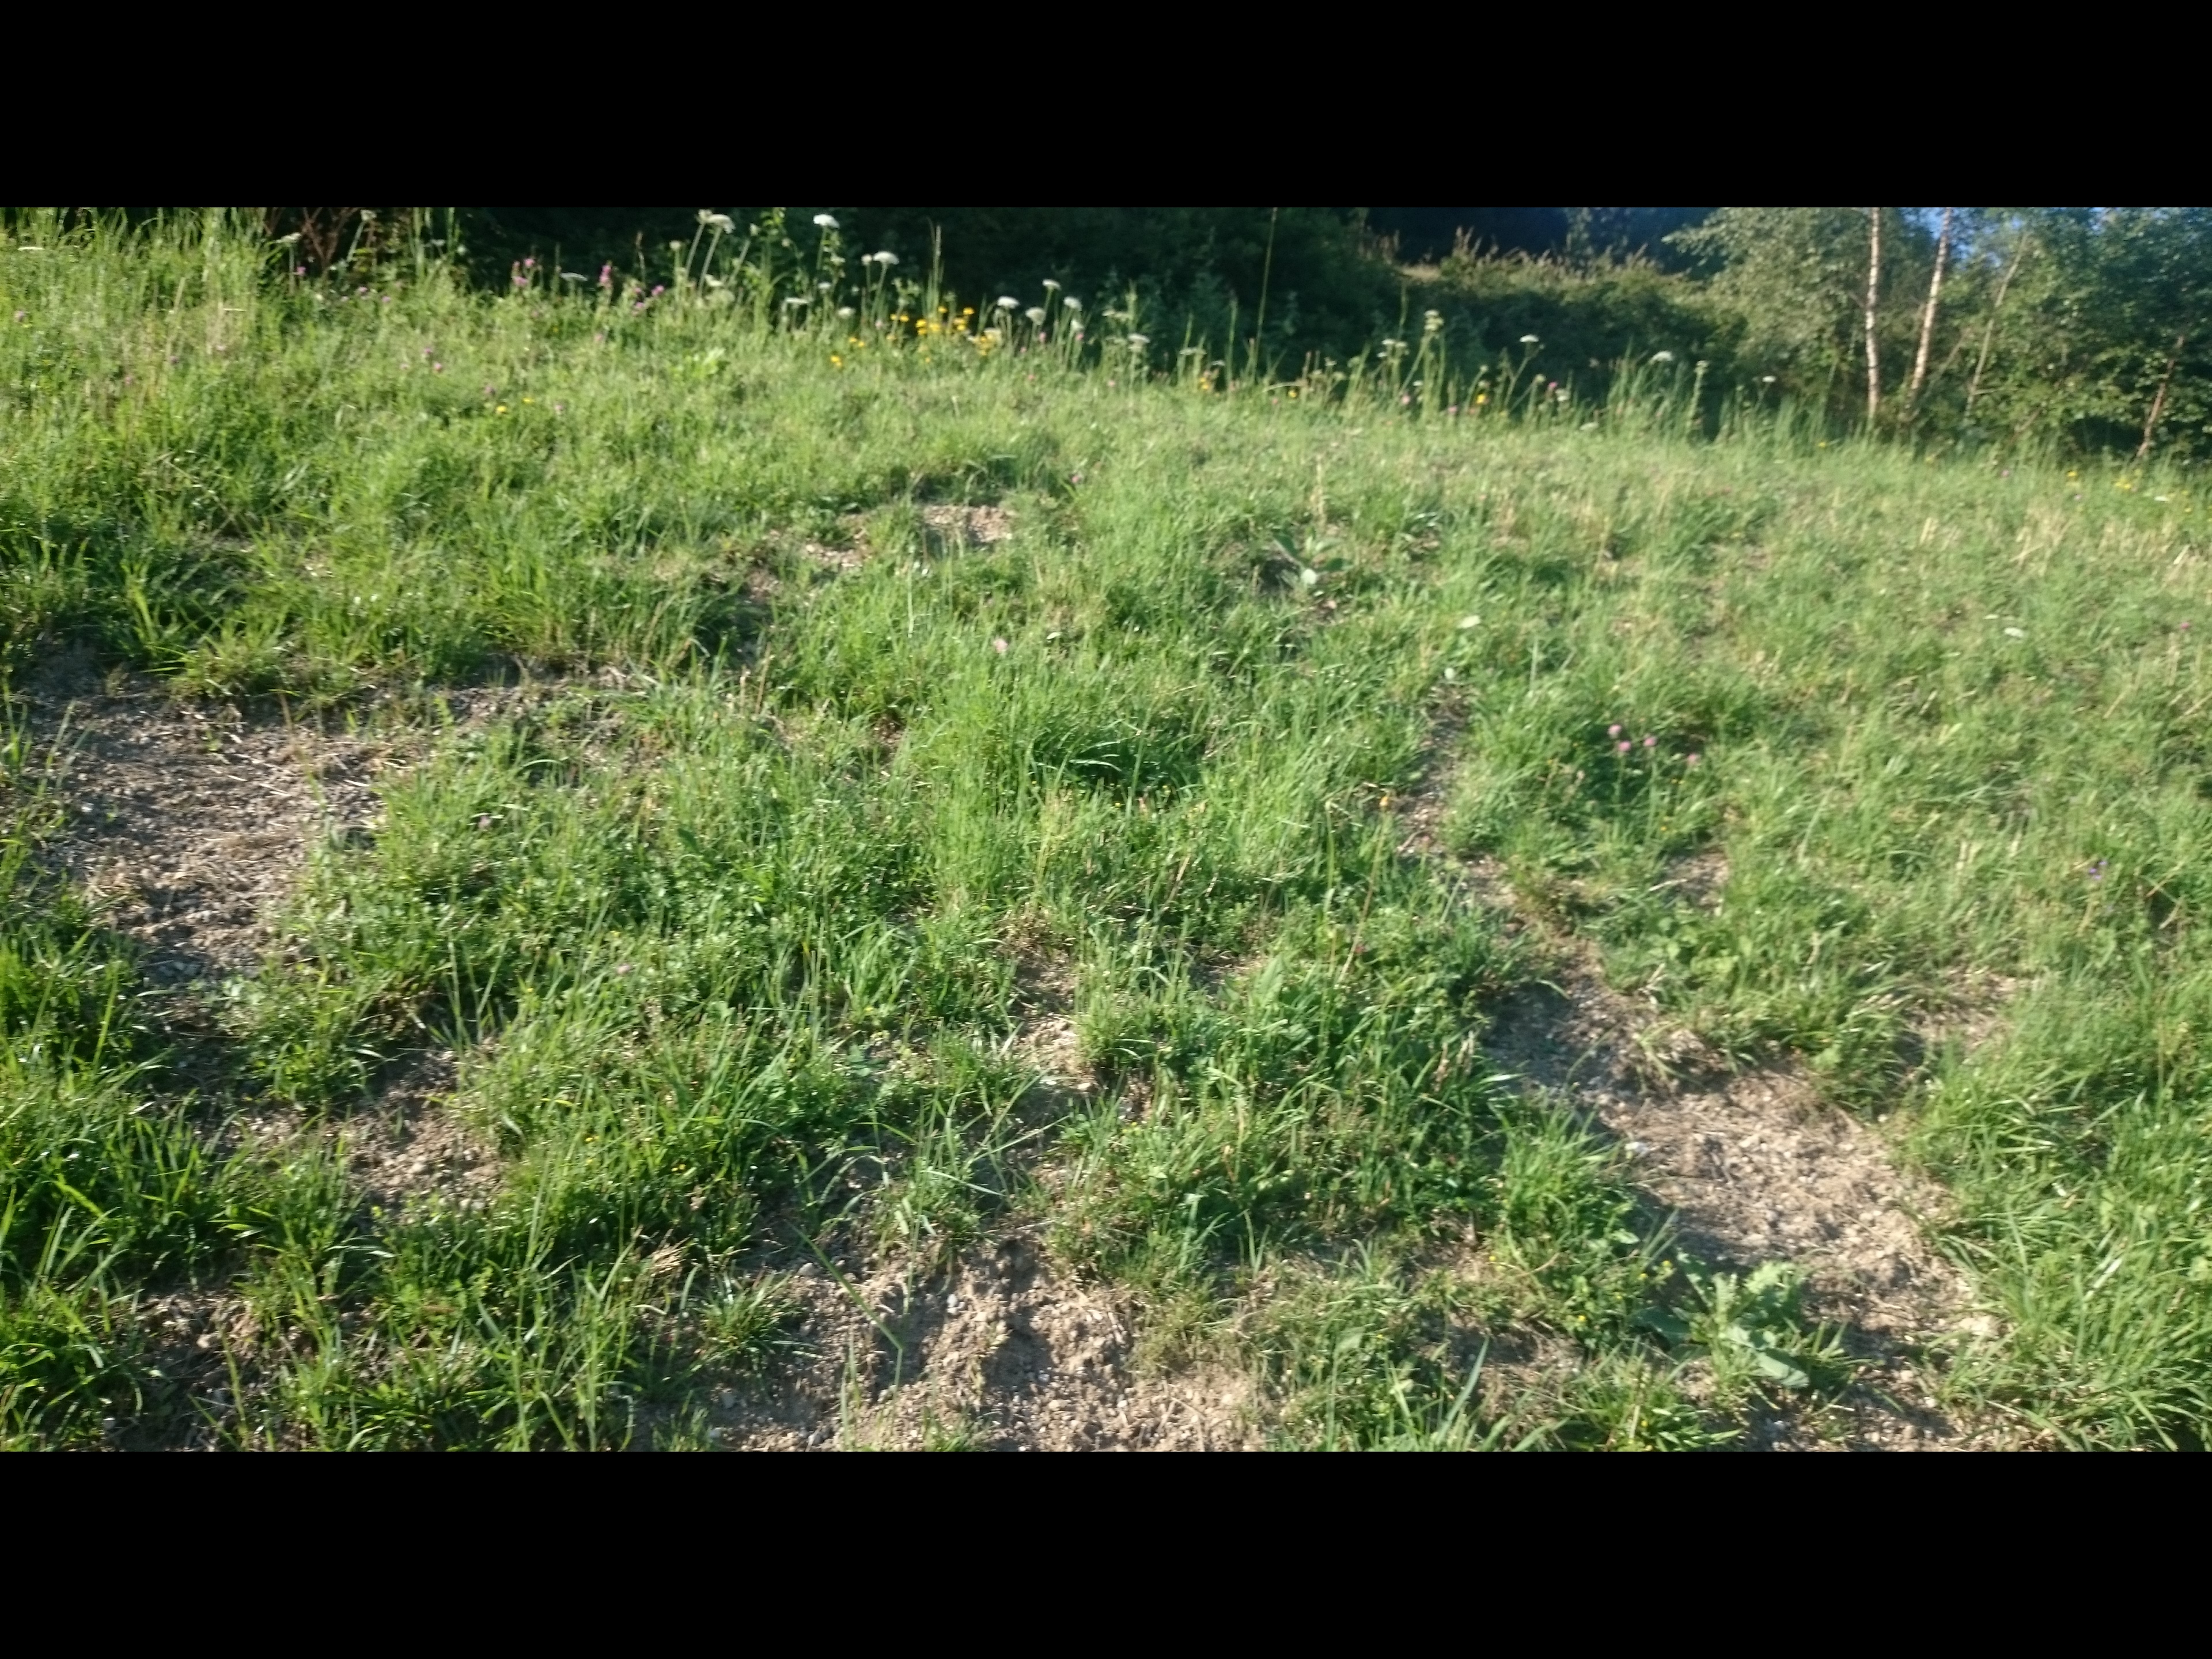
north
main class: Grassland
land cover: Grassland without tree/shrub cover
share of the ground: > 75 %
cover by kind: herbaceous plants 90 %, consolidated bare surface 5 %, unconsolidated bare surface 5 %
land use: Agriculture (excluding fallow land and kitchen gardens)
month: July
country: AT
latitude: 48.2891
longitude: 15.0286
